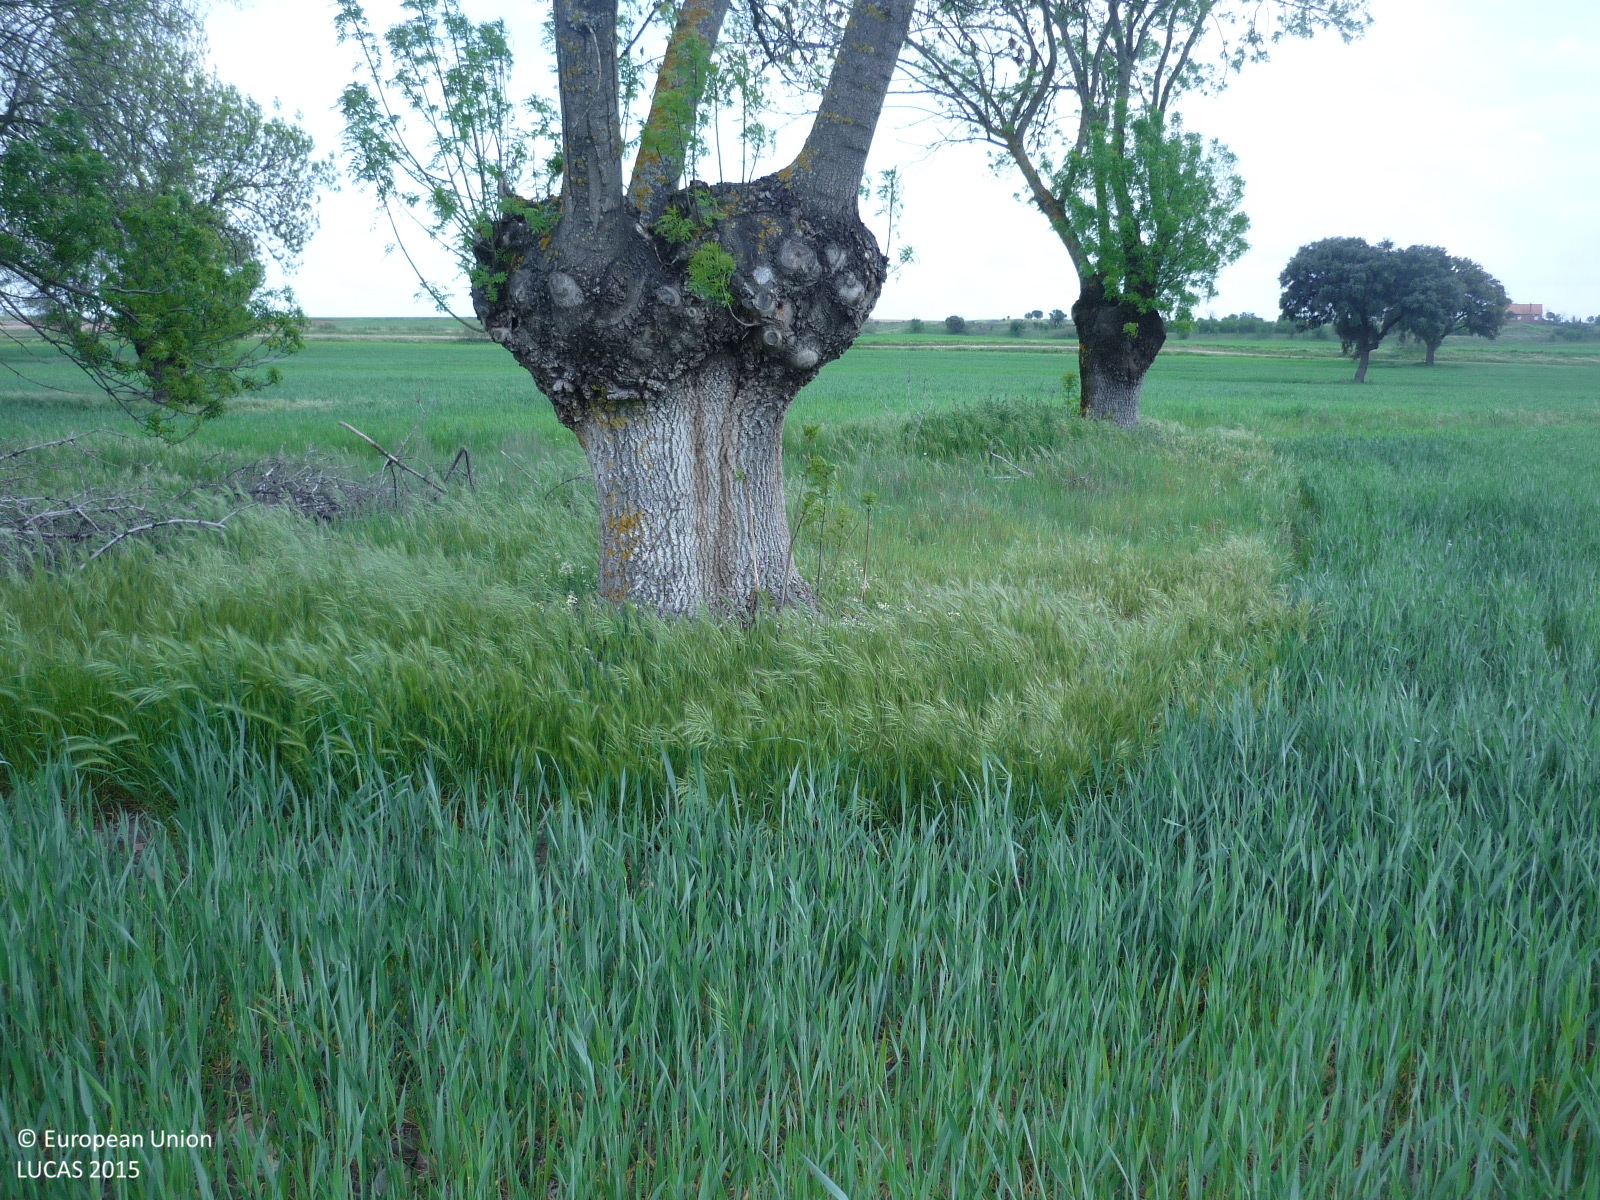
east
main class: Cropland
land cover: Common wheat
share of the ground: > 75 %
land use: Agriculture (excluding fallow land and kitchen gardens)
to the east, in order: Common wheat; Broadleaved woodland; Grass margins; Broadleaved woodland; Oats; Grass margins; Tracks; Grass margins; Barley
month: April
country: ES
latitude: 40.6615
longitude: -3.5344
